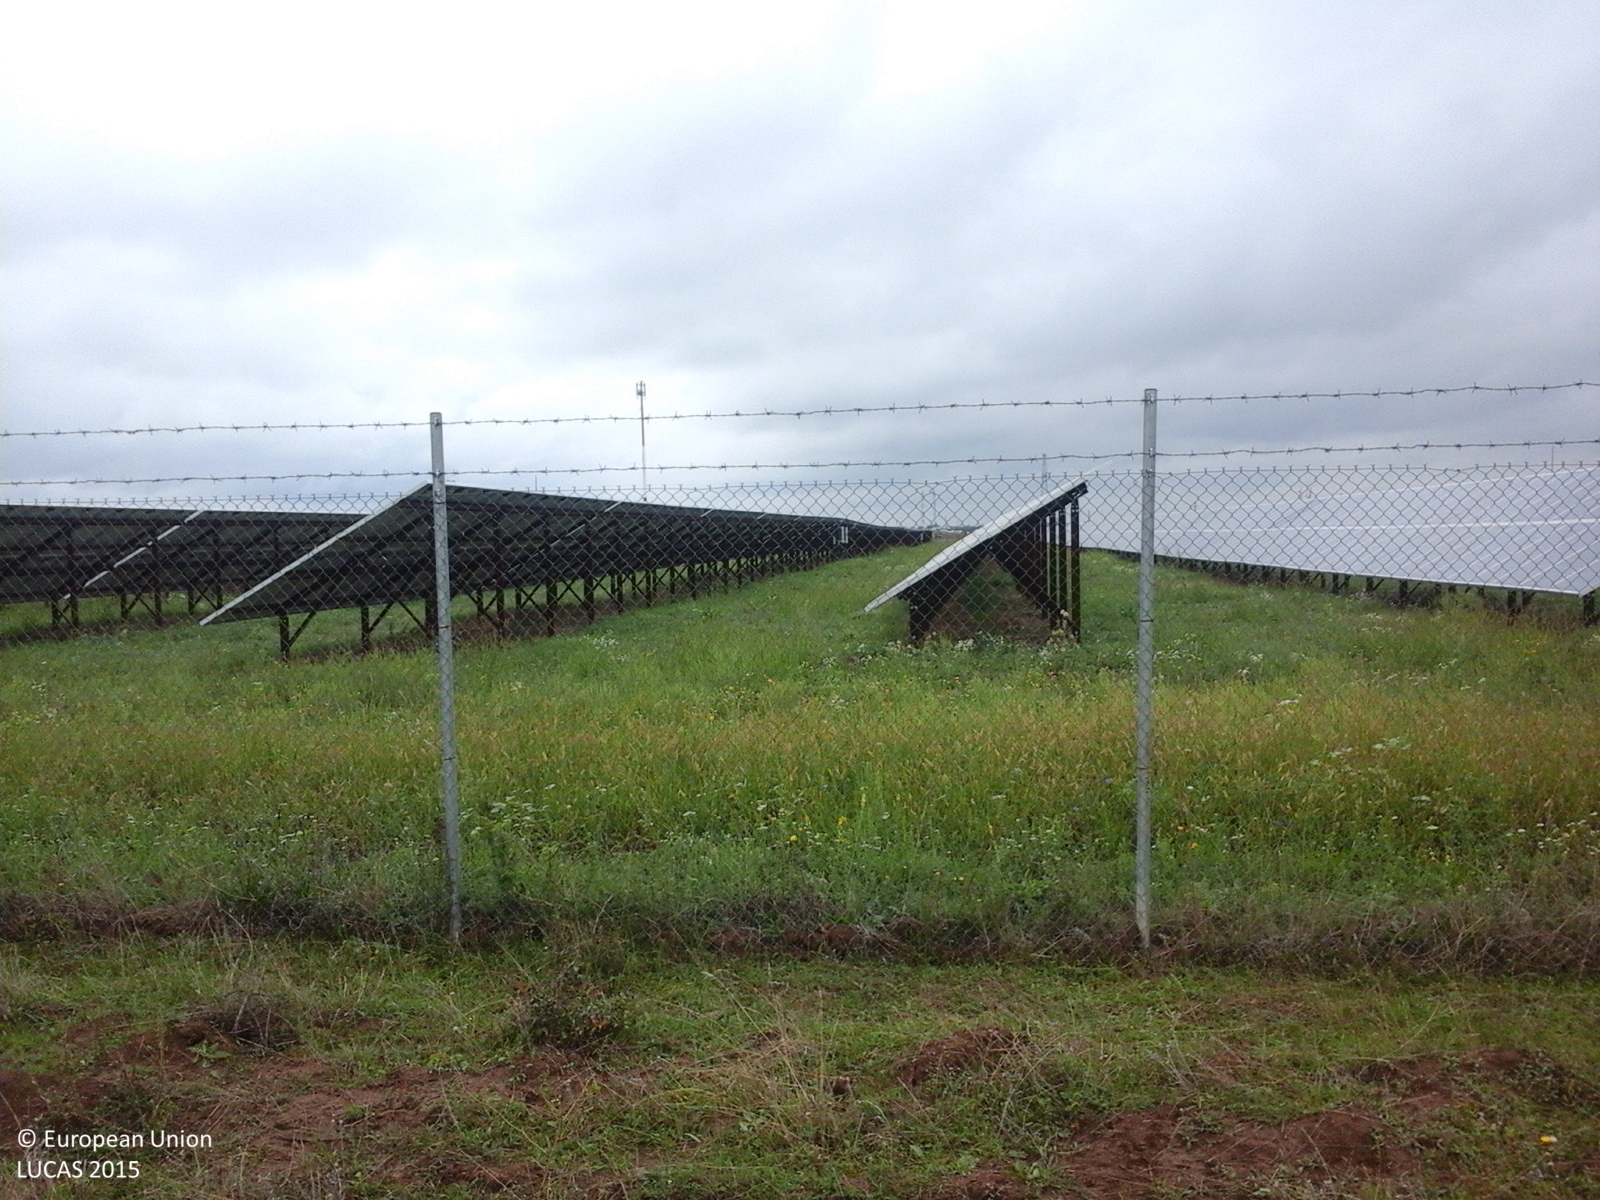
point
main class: Artificial land
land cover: Non built-up area features
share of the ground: 50 - 75 %
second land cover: Grassland without tree/shrub cover
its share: > 75 %
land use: Energy production
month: September
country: RO
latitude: 46.9298
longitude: 21.8254
